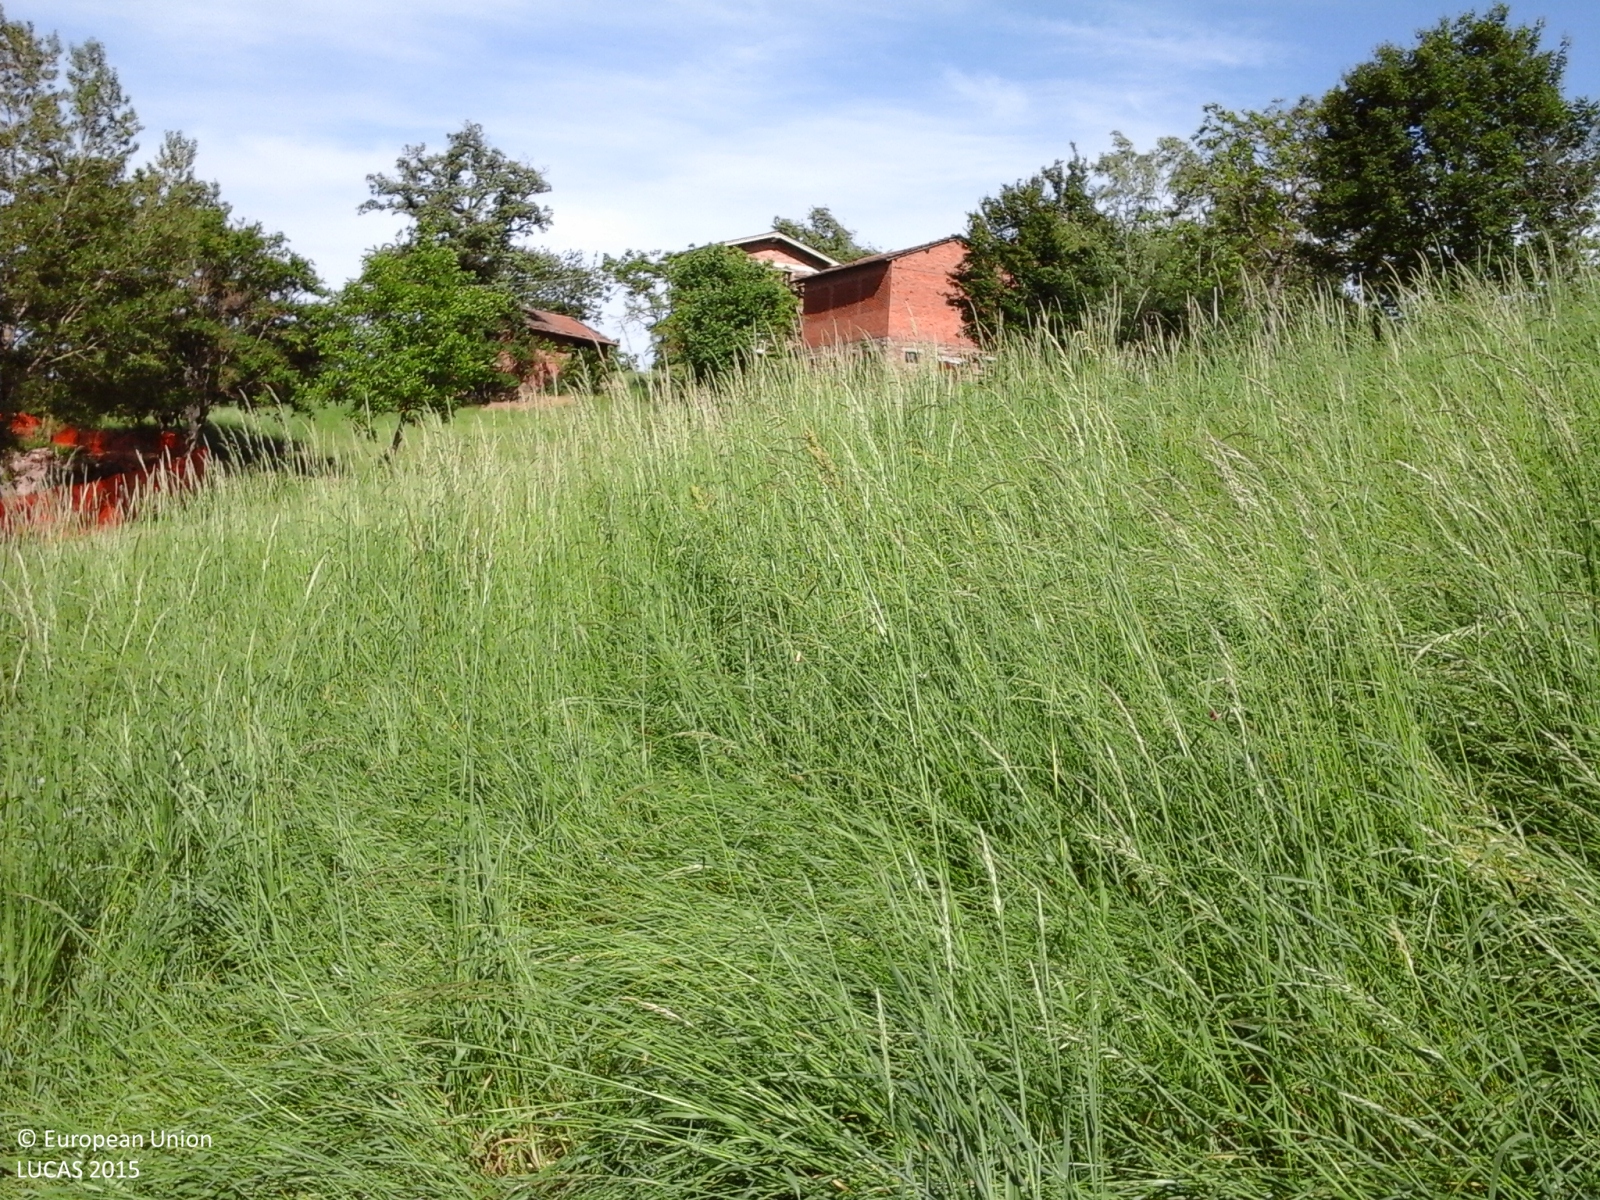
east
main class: Grassland
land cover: Grassland without tree/shrub cover
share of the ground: > 75 %
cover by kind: herbaceous plants 100 %
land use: Agriculture (excluding fallow land and kitchen gardens)
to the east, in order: Grassland without tree/shrub cover; Vineyards; Grassland without tree/shrub cover; Artificial constructions in urban areas; Broadleaved woodland; Rocks and stones
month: May
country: IT
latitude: 44.3661
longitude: 10.7136
